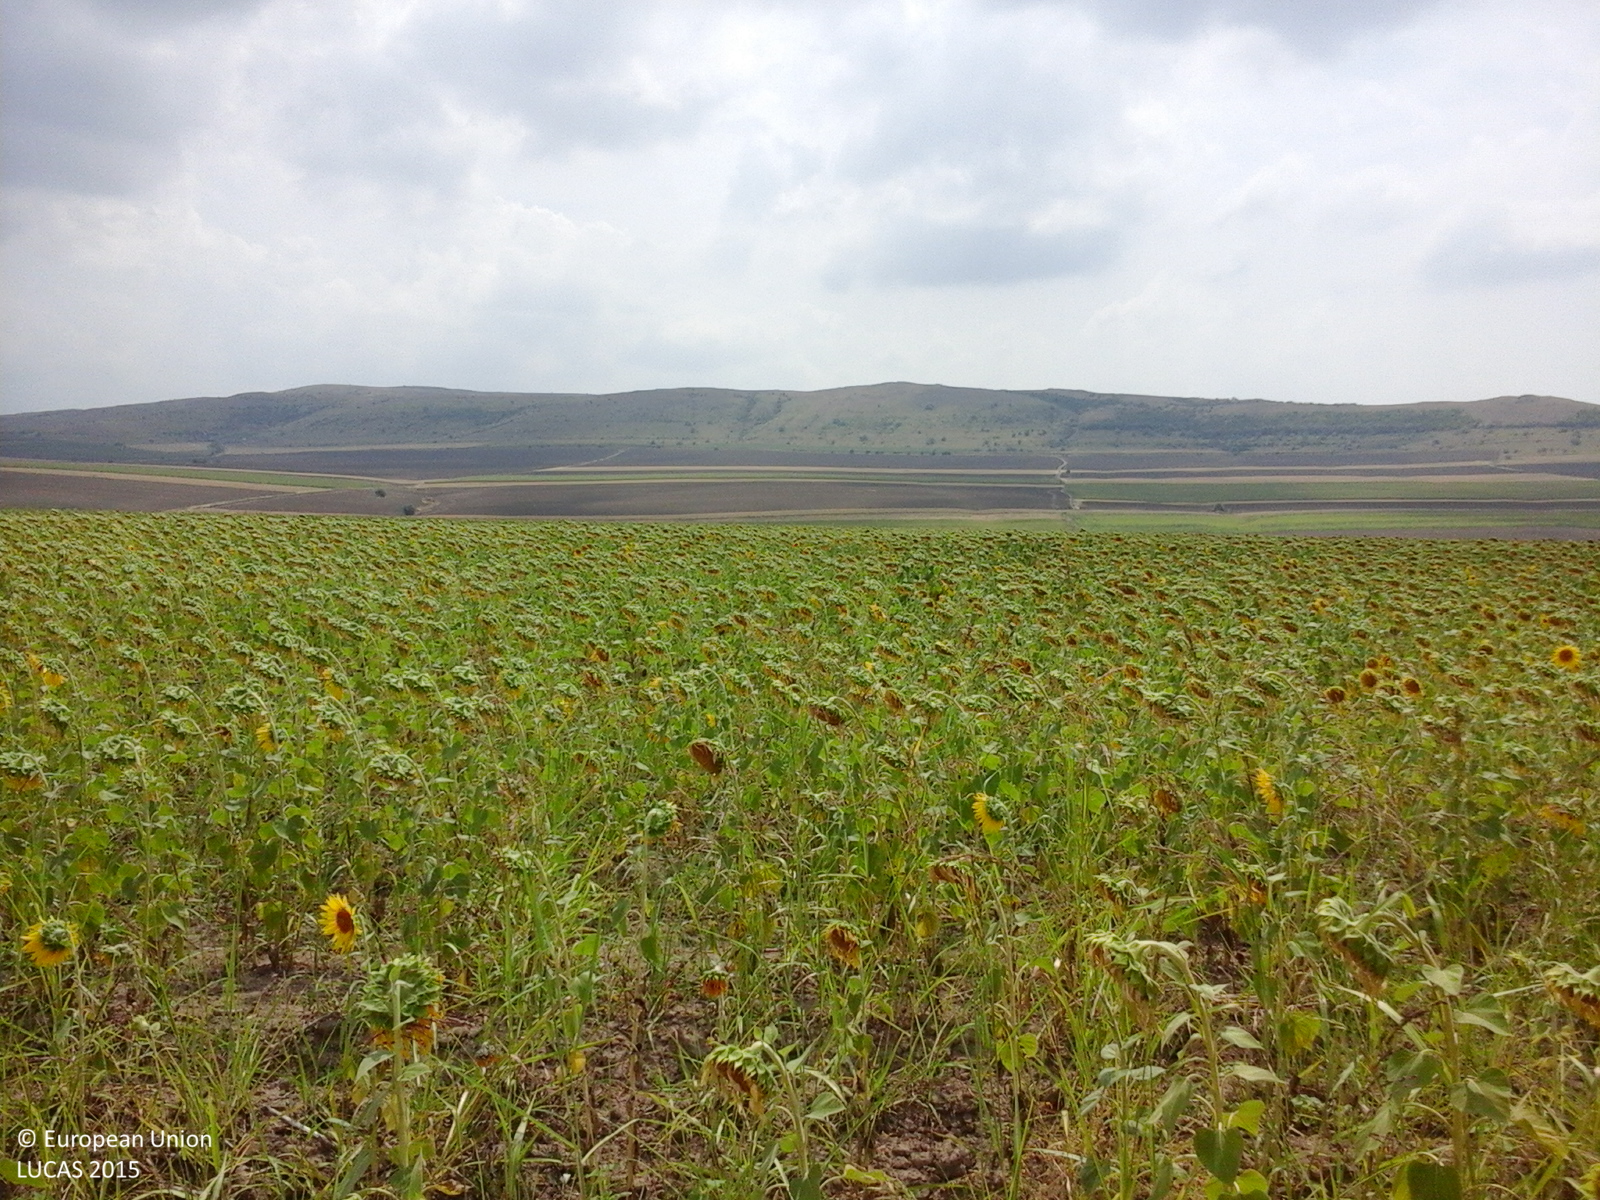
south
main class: Cropland
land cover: Sunflower
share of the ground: > 75 %
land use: Agriculture (excluding fallow land and kitchen gardens)
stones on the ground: < 10 %
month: July
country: RO
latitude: 44.9861
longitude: 28.2441
